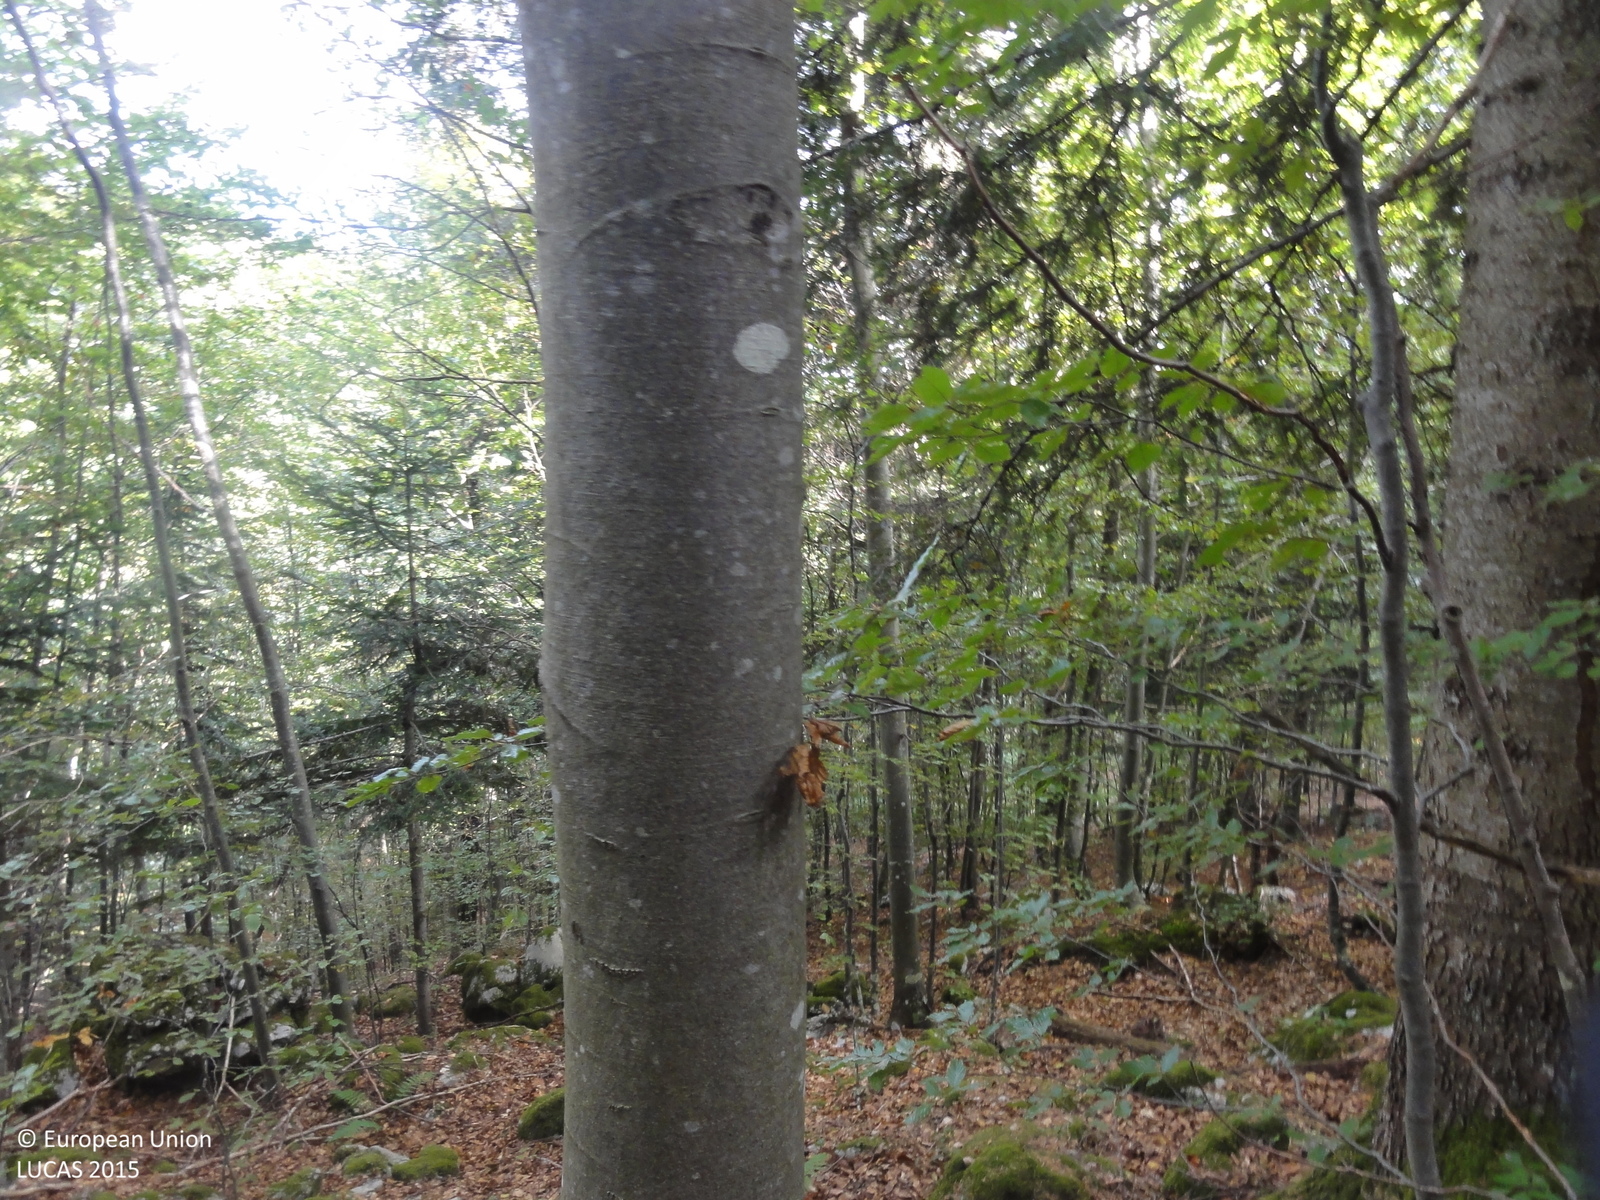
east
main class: Woodland
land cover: Spruce dominated mixed woodland
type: mountainous beech forest
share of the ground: > 75 %
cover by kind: broadleaved forest trees 60 %, coniferous forest trees 40 %
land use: Forestry
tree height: > 5 m
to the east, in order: Spruce dominated mixed woodland; Tracks; Spruce dominated mixed woodland; Tracks; Spruce dominated mixed woodland; Tracks; Spruce dominated mixed woodland
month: September
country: SI
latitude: 45.6729
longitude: 15.0410
